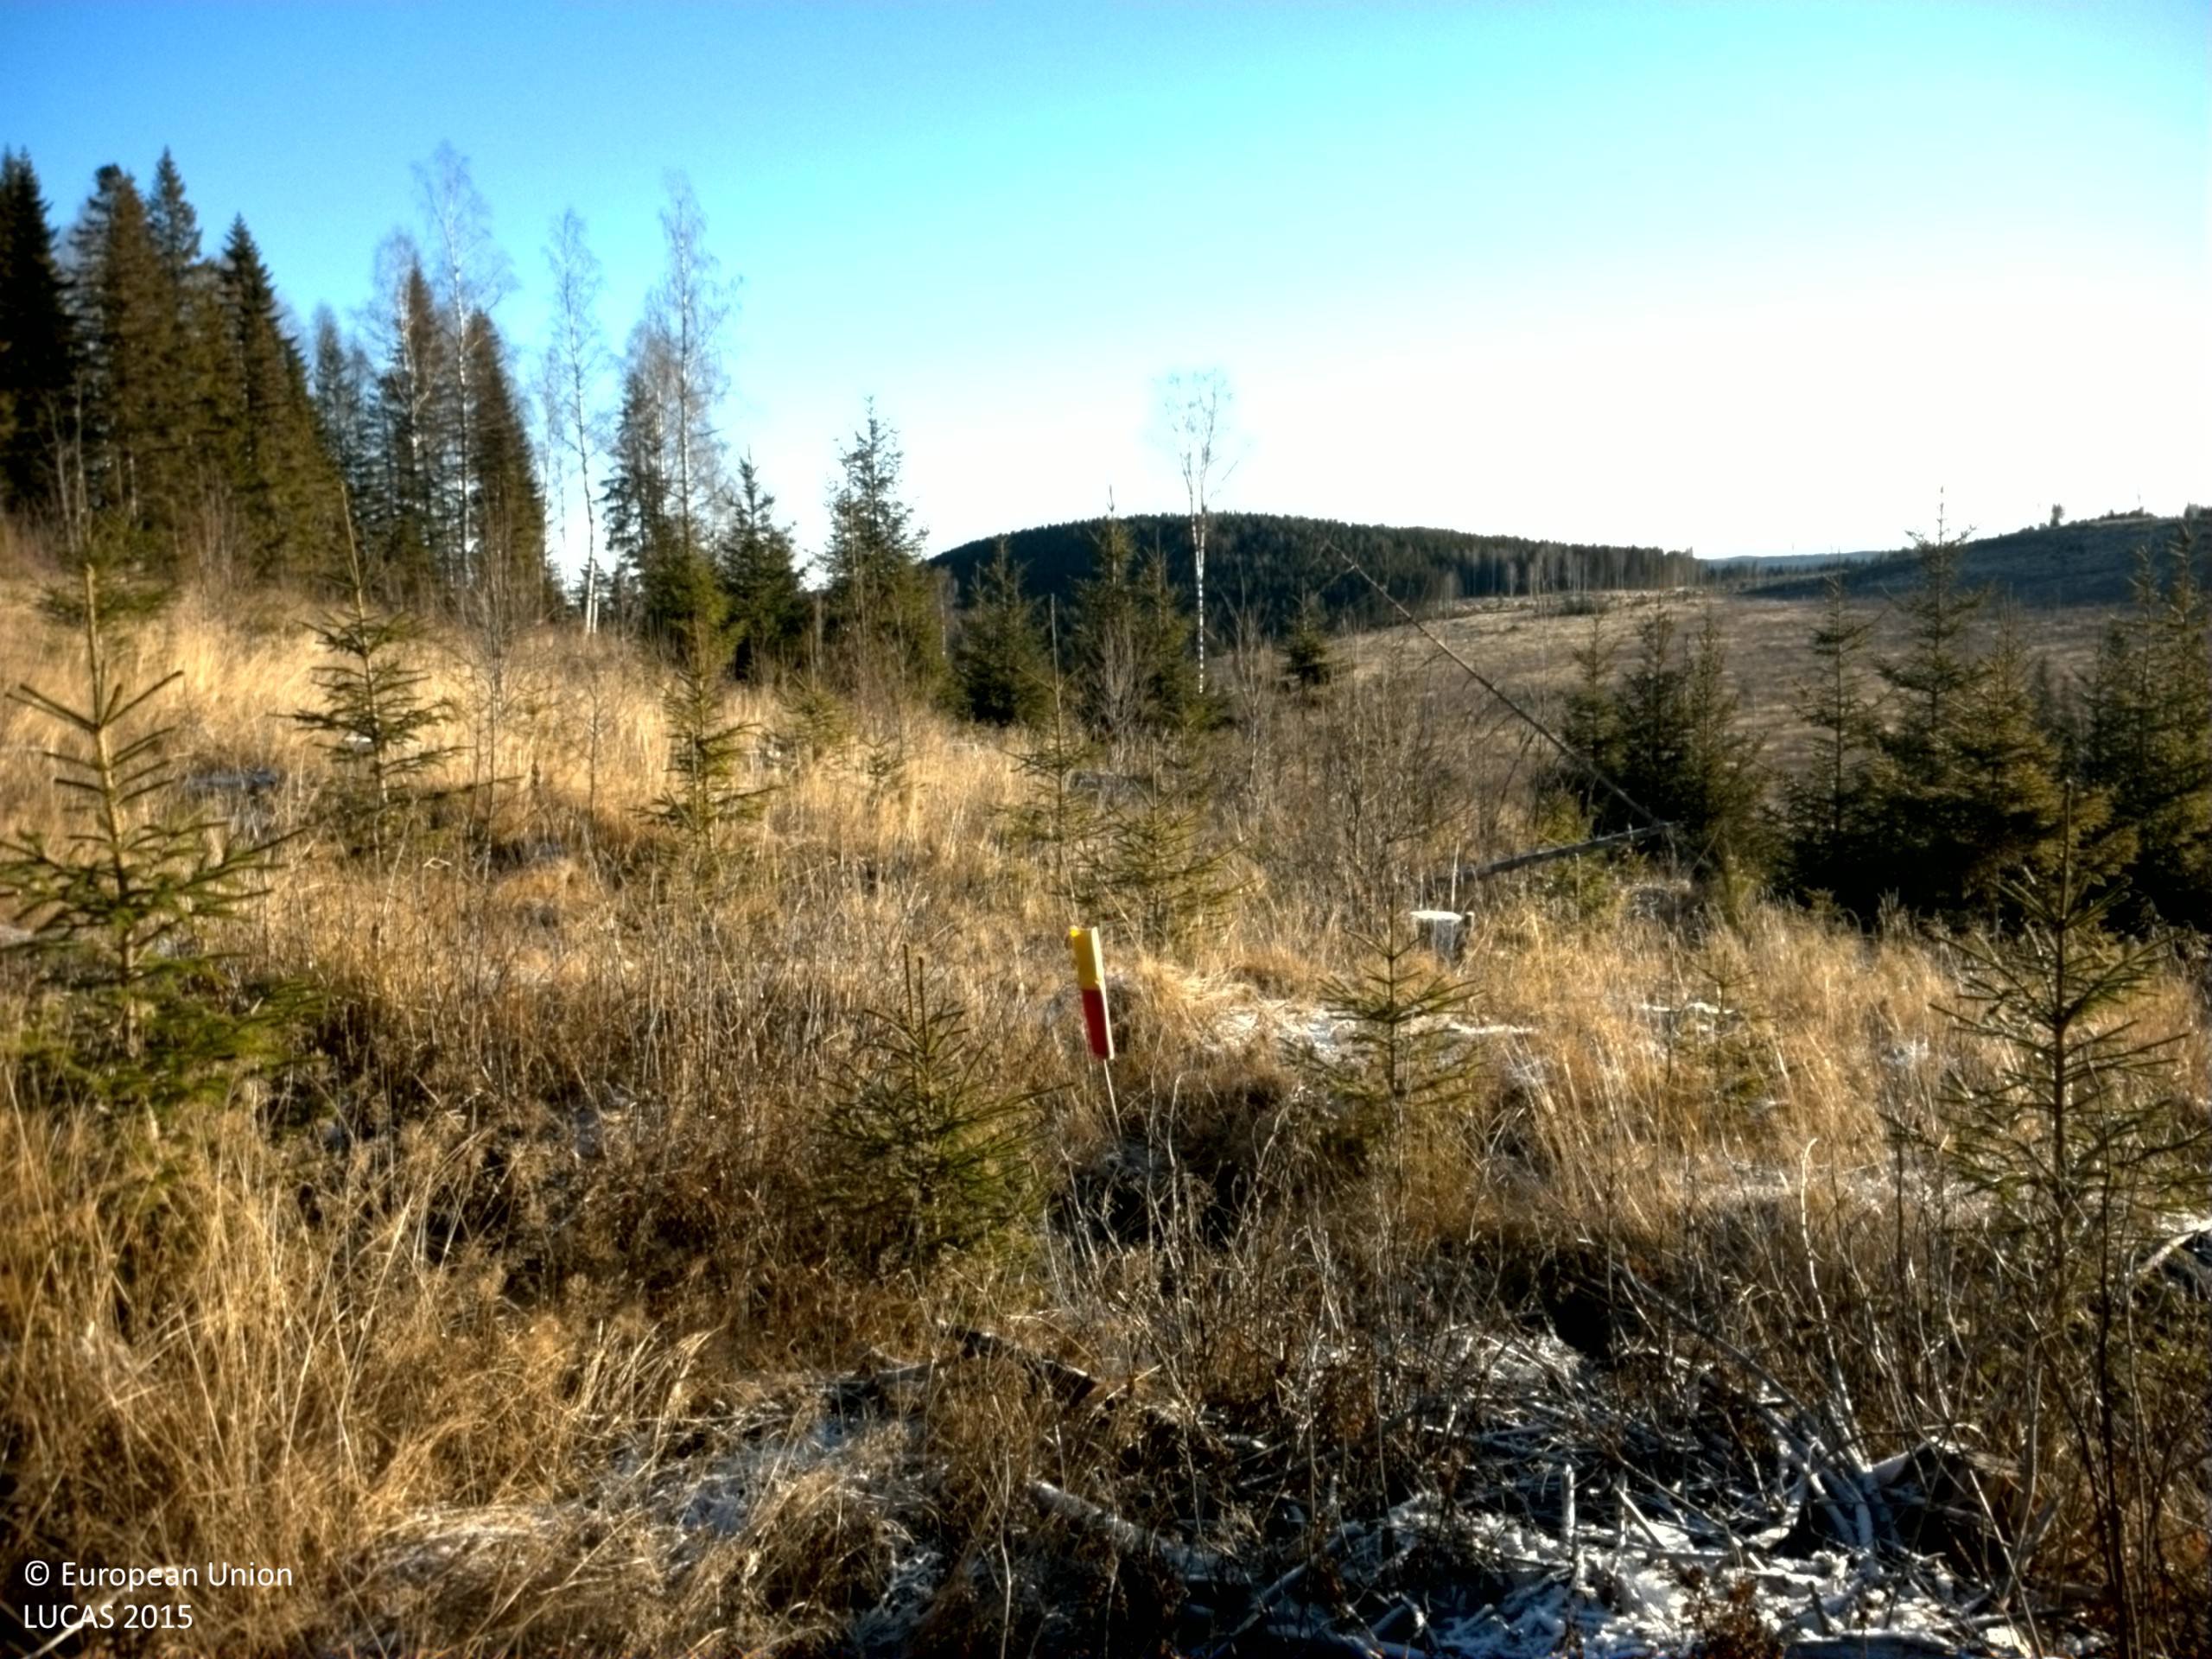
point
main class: Woodland
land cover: Spruce dominated mixed woodland
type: boreal forest
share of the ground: 25 - 50 %
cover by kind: herbaceous plants 50 %, coniferous forest trees 25 %, broadleaved forest trees 10 %, lichens and mosses 10 %, shrubs 5 %
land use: Forestry
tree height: < 5 m
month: November
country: SE
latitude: 61.8877
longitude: 16.2029
